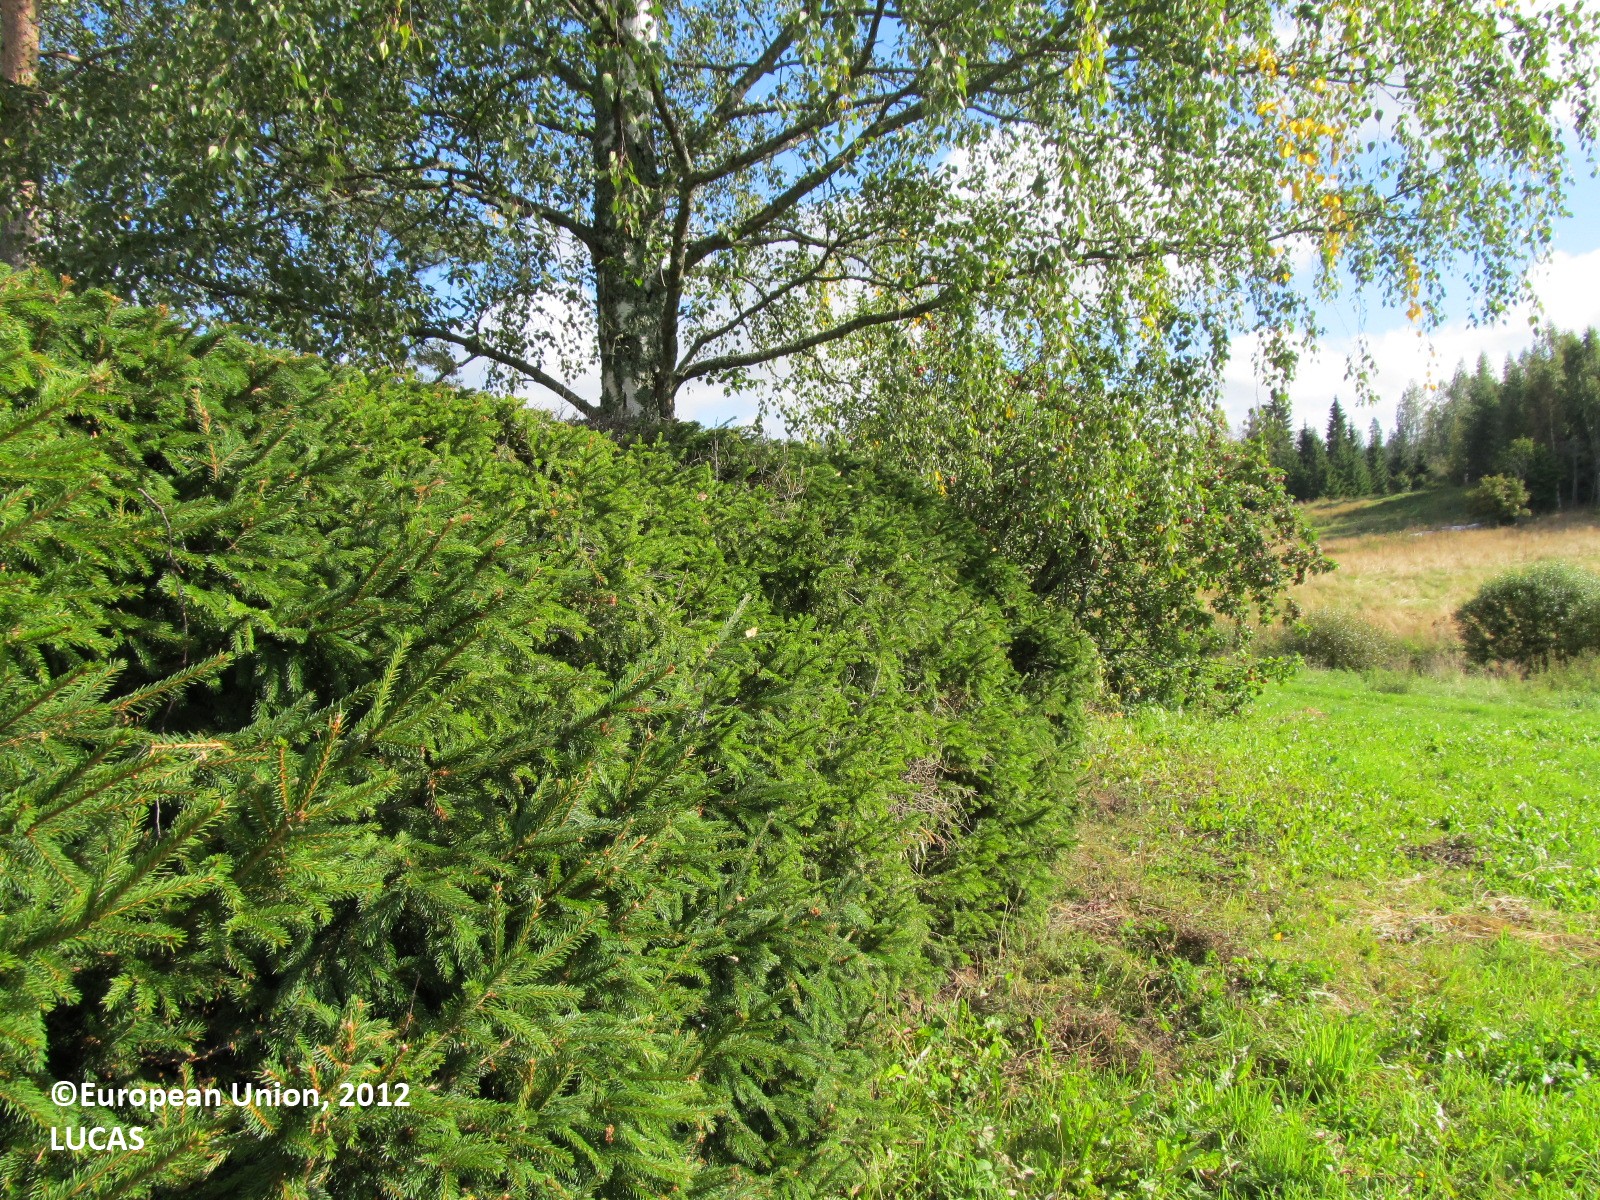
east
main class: Cropland
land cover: Temporary grasslands
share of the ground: 50 - 75 %
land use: Agriculture (excluding fallow land and kitchen gardens)
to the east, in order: Temporary grasslands; Managed hedges; Single bushes/trees; Apple fruit; Grassland without tree/shrub cover; Ditches and canals; Grassland without tree/shrub cover; Broadleaved woodland; Ditches and canals; Broadleaved woodland; Ditches and canals; Paved roads, cycling and walking lanes; Ditches and canals; Grassland without tree/shrub cover; Paved roads, cycling and walking lanes; Grassland without tree/shrub cover
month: September
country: FI
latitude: 62.9723
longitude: 28.2347
